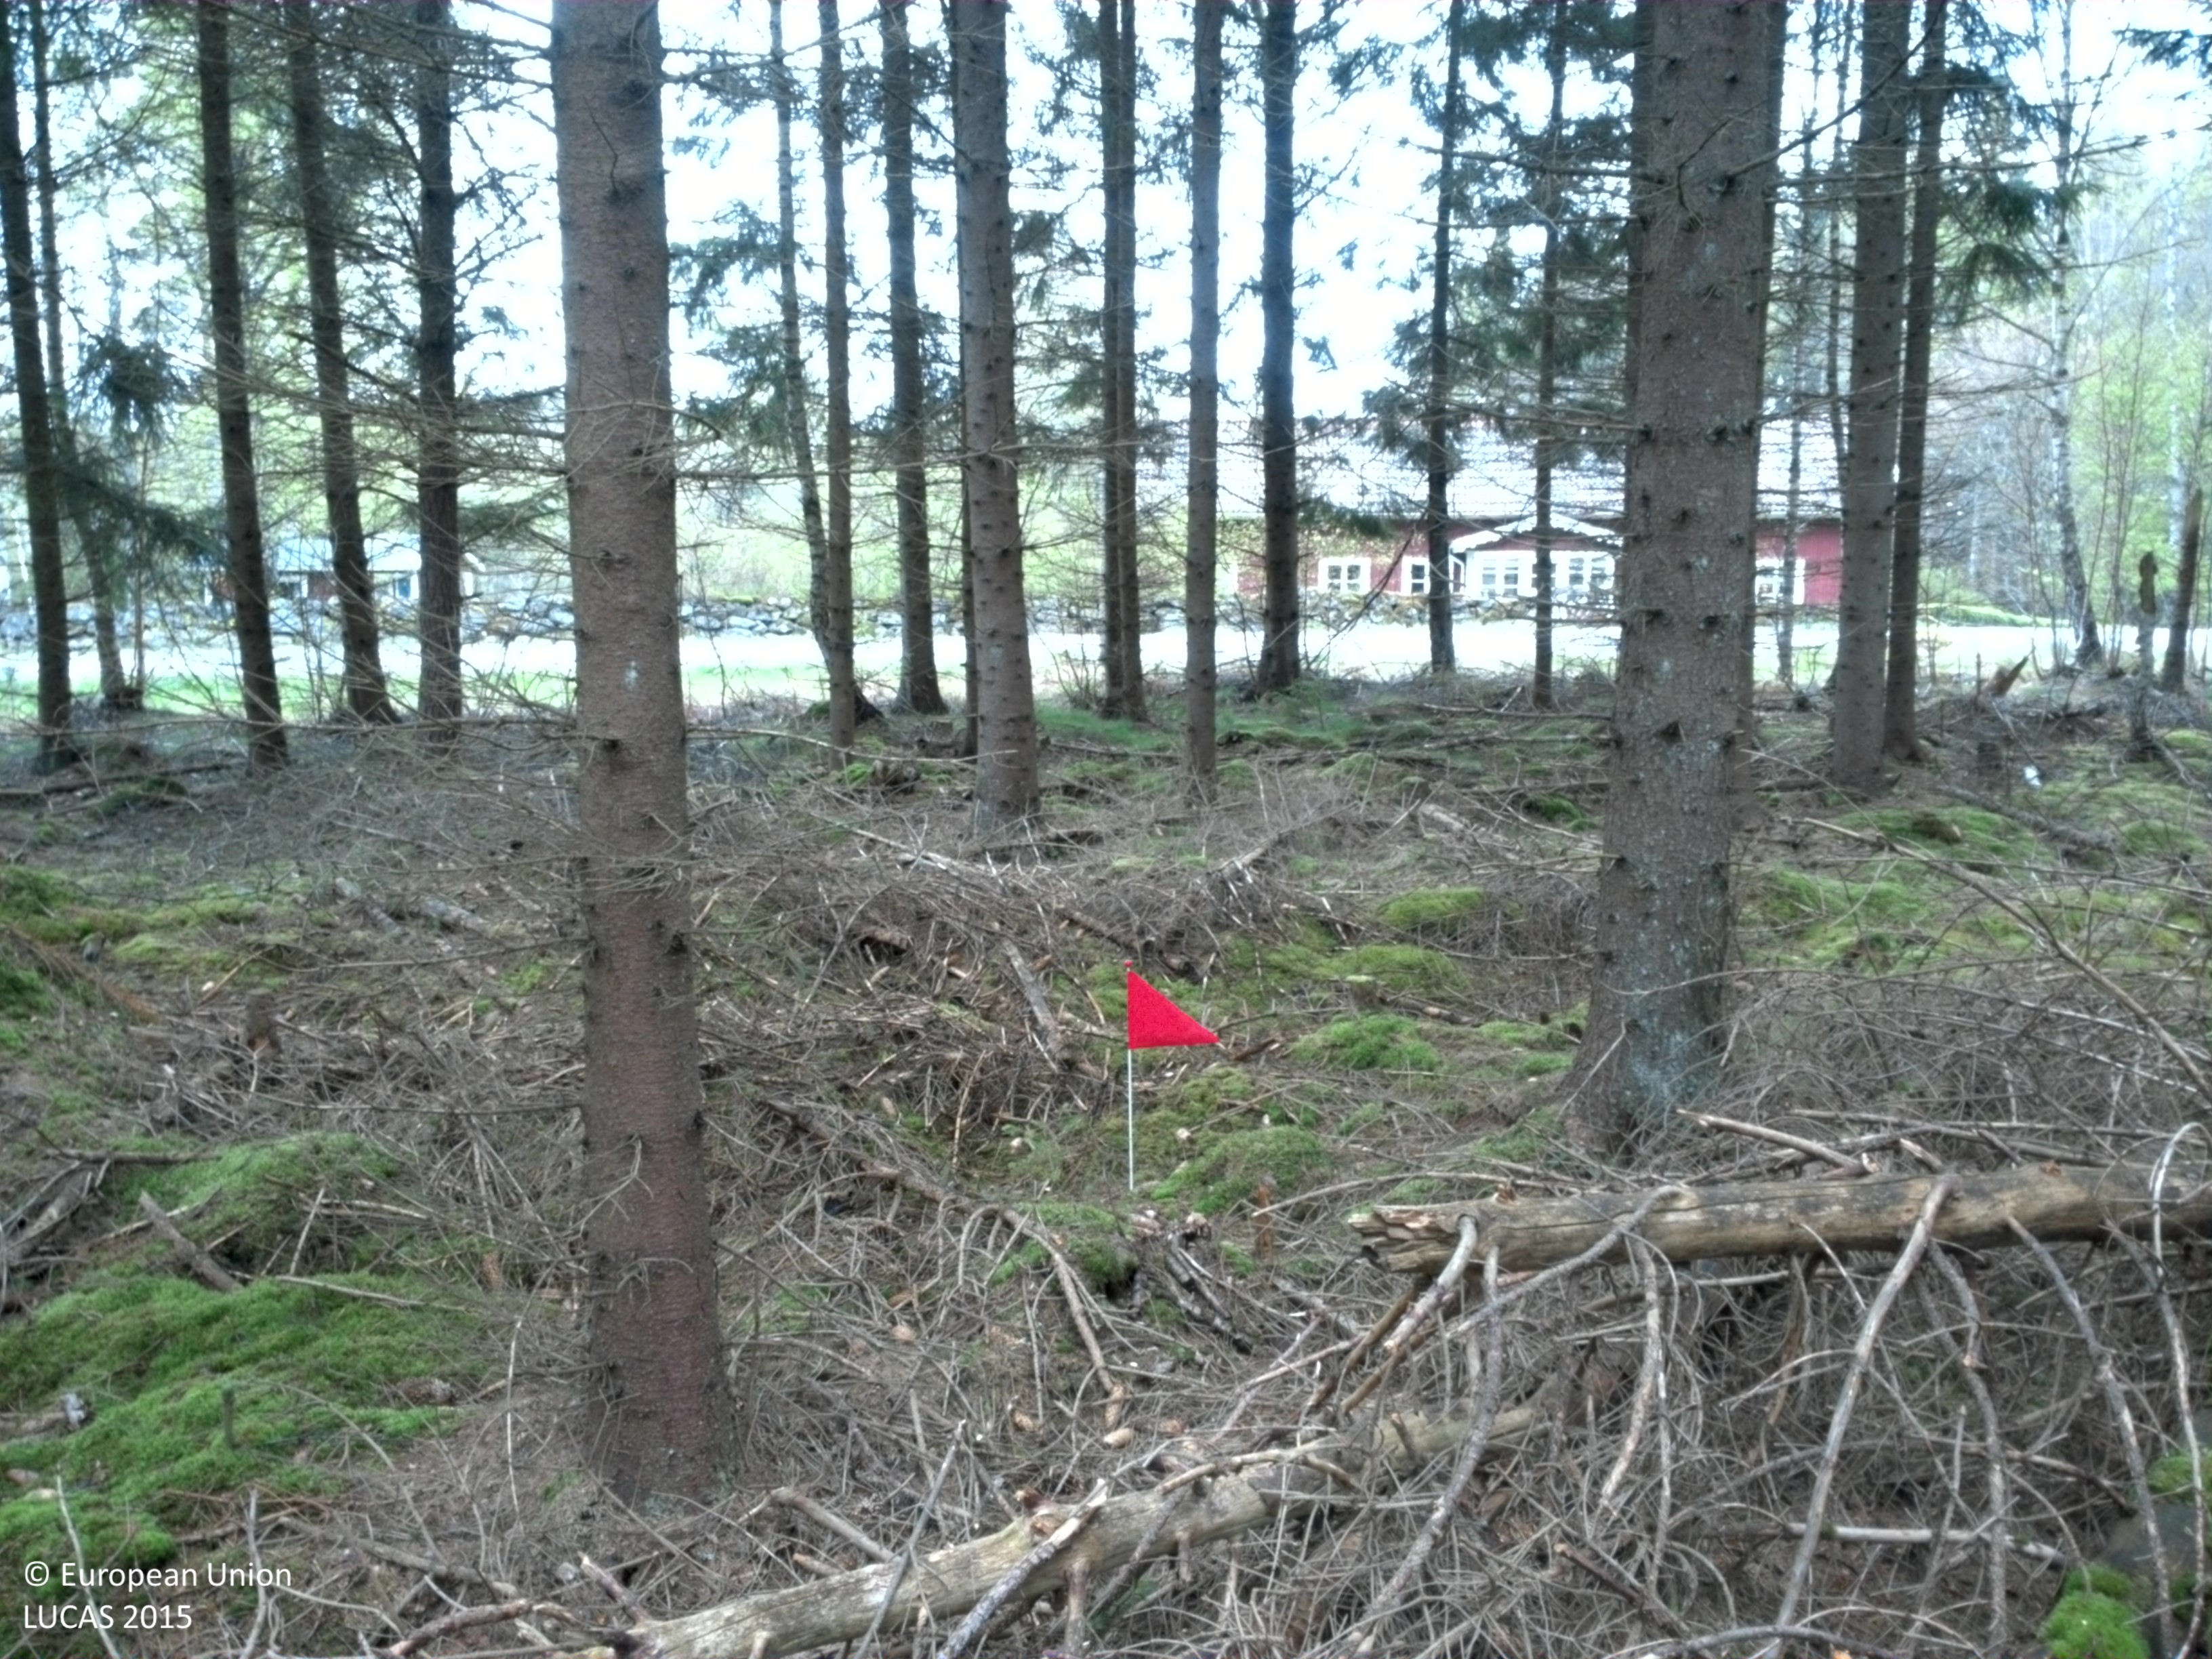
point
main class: Woodland
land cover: Spruce dominated coniferous woodland
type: boreal forest
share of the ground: > 75 %
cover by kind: coniferous forest trees 80 %, broadleaved forest trees 10 %, lichens and mosses 10 %
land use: Forestry
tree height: > 5 m
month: May
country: SE
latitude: 56.6654
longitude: 15.0396
